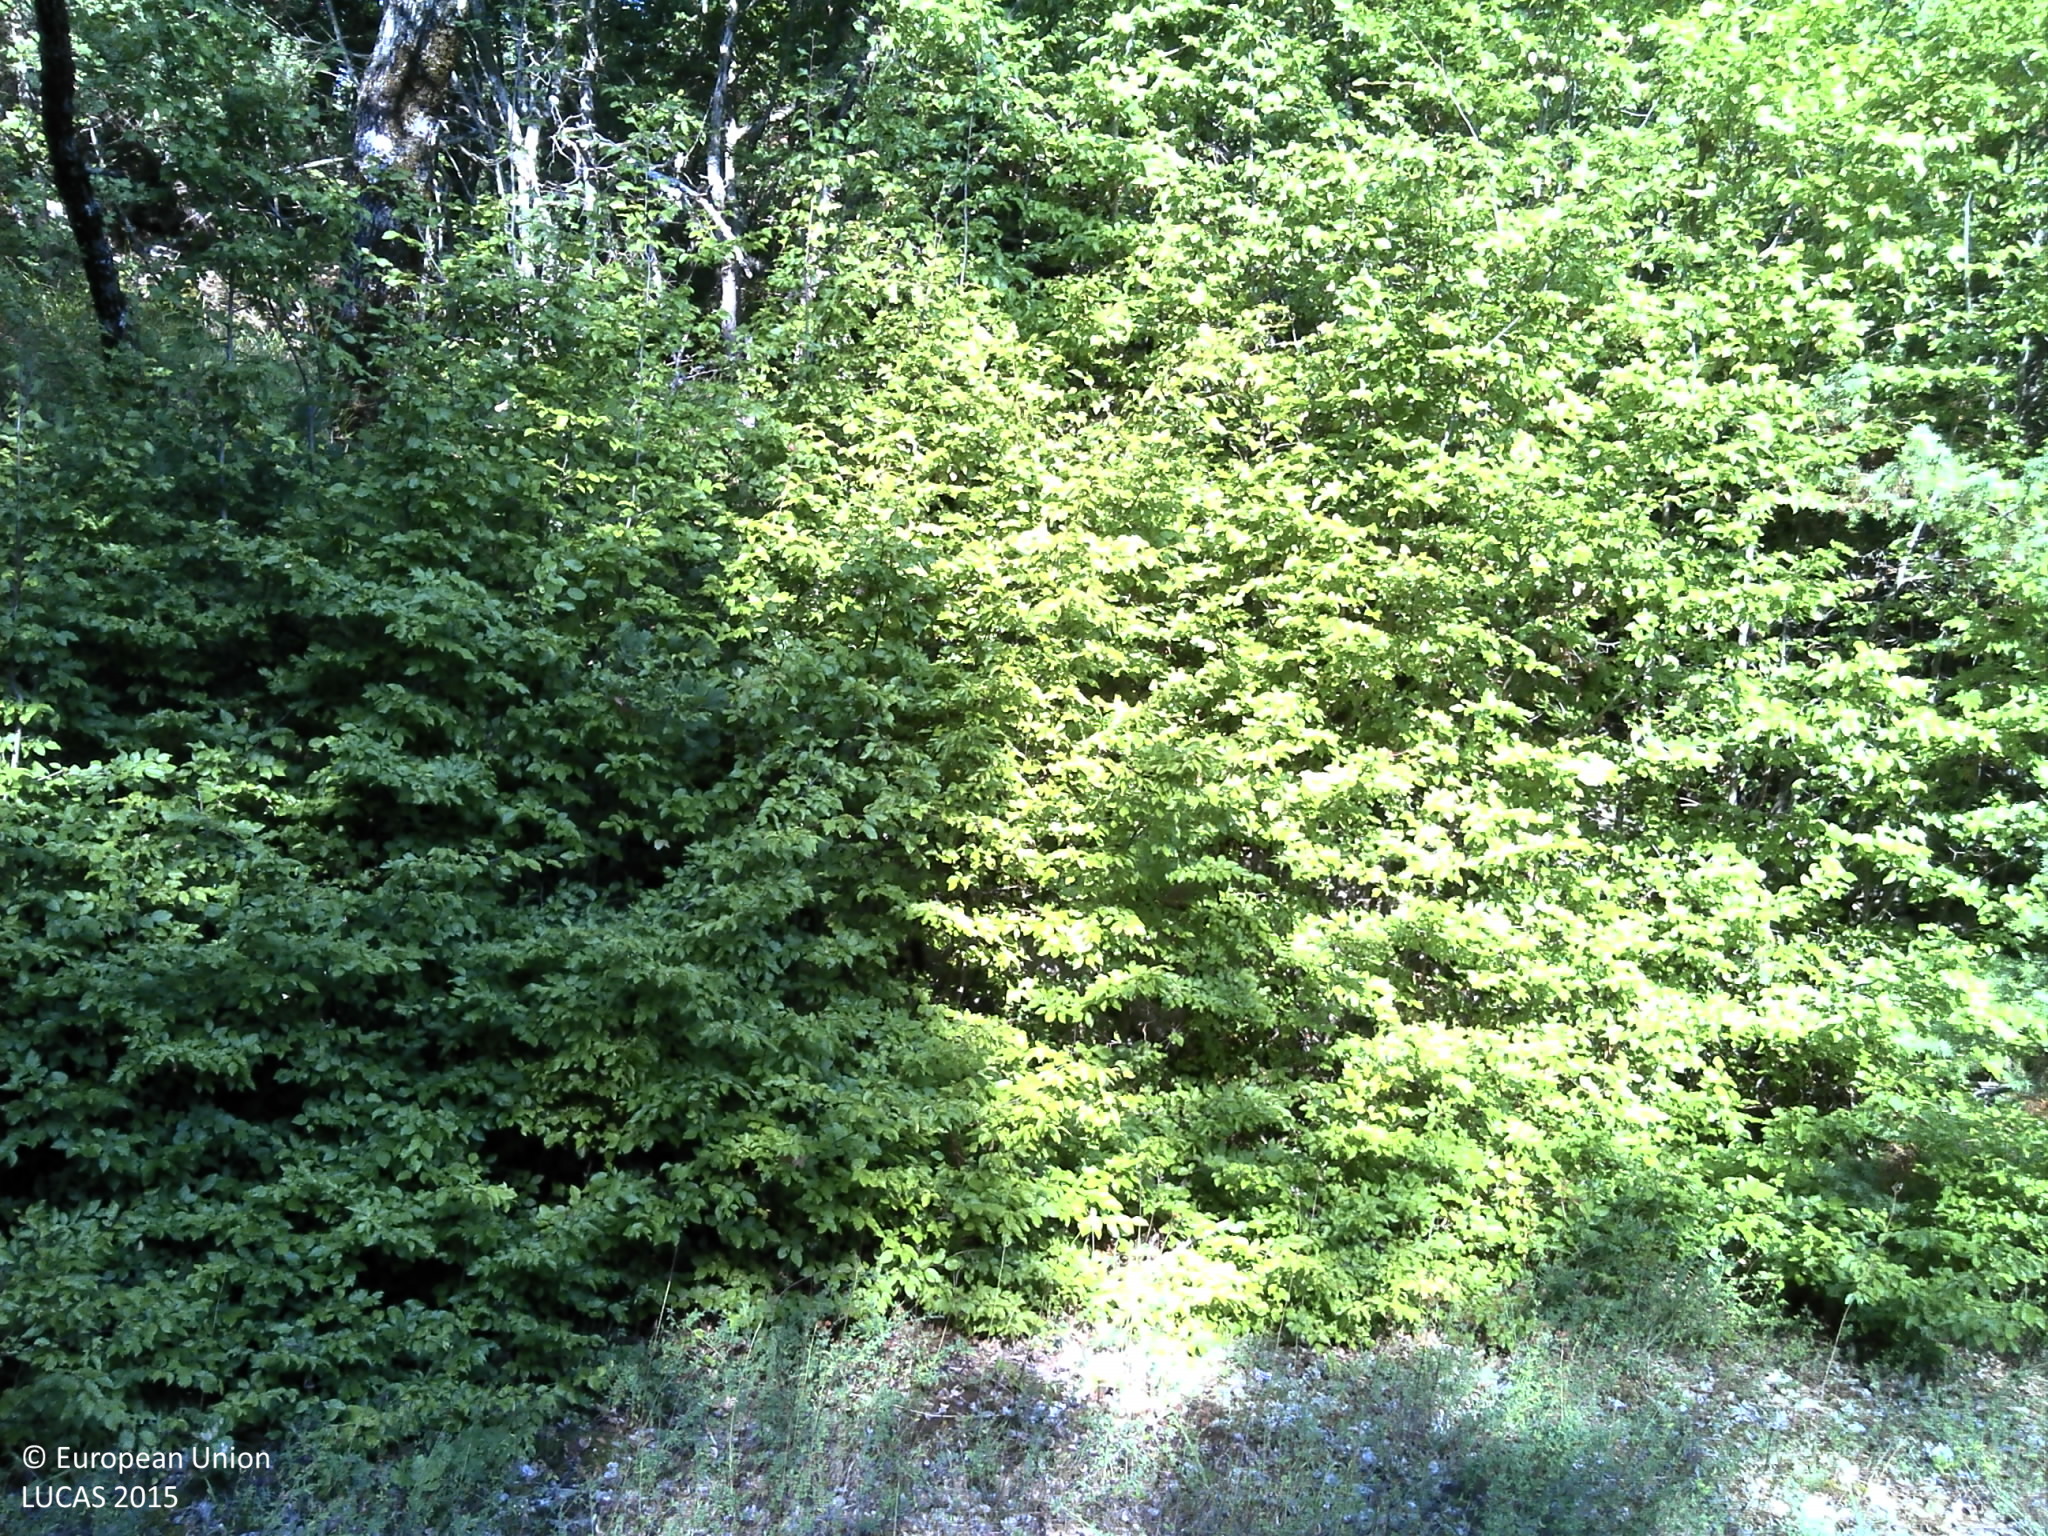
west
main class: Woodland
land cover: Other mixed woodland
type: thermophilous deciduous forest
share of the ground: > 75 %
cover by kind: broadleaved forest trees 30 %, shrubs 30 %, herbaceous plants 15 %, coniferous forest trees 10 %, unconsolidated bare surface 10 %, consolidated bare surface 5 %
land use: Semi-natural and natural areas not in use
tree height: > 5 m
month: August
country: HR
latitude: 43.3427
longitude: 17.1582
